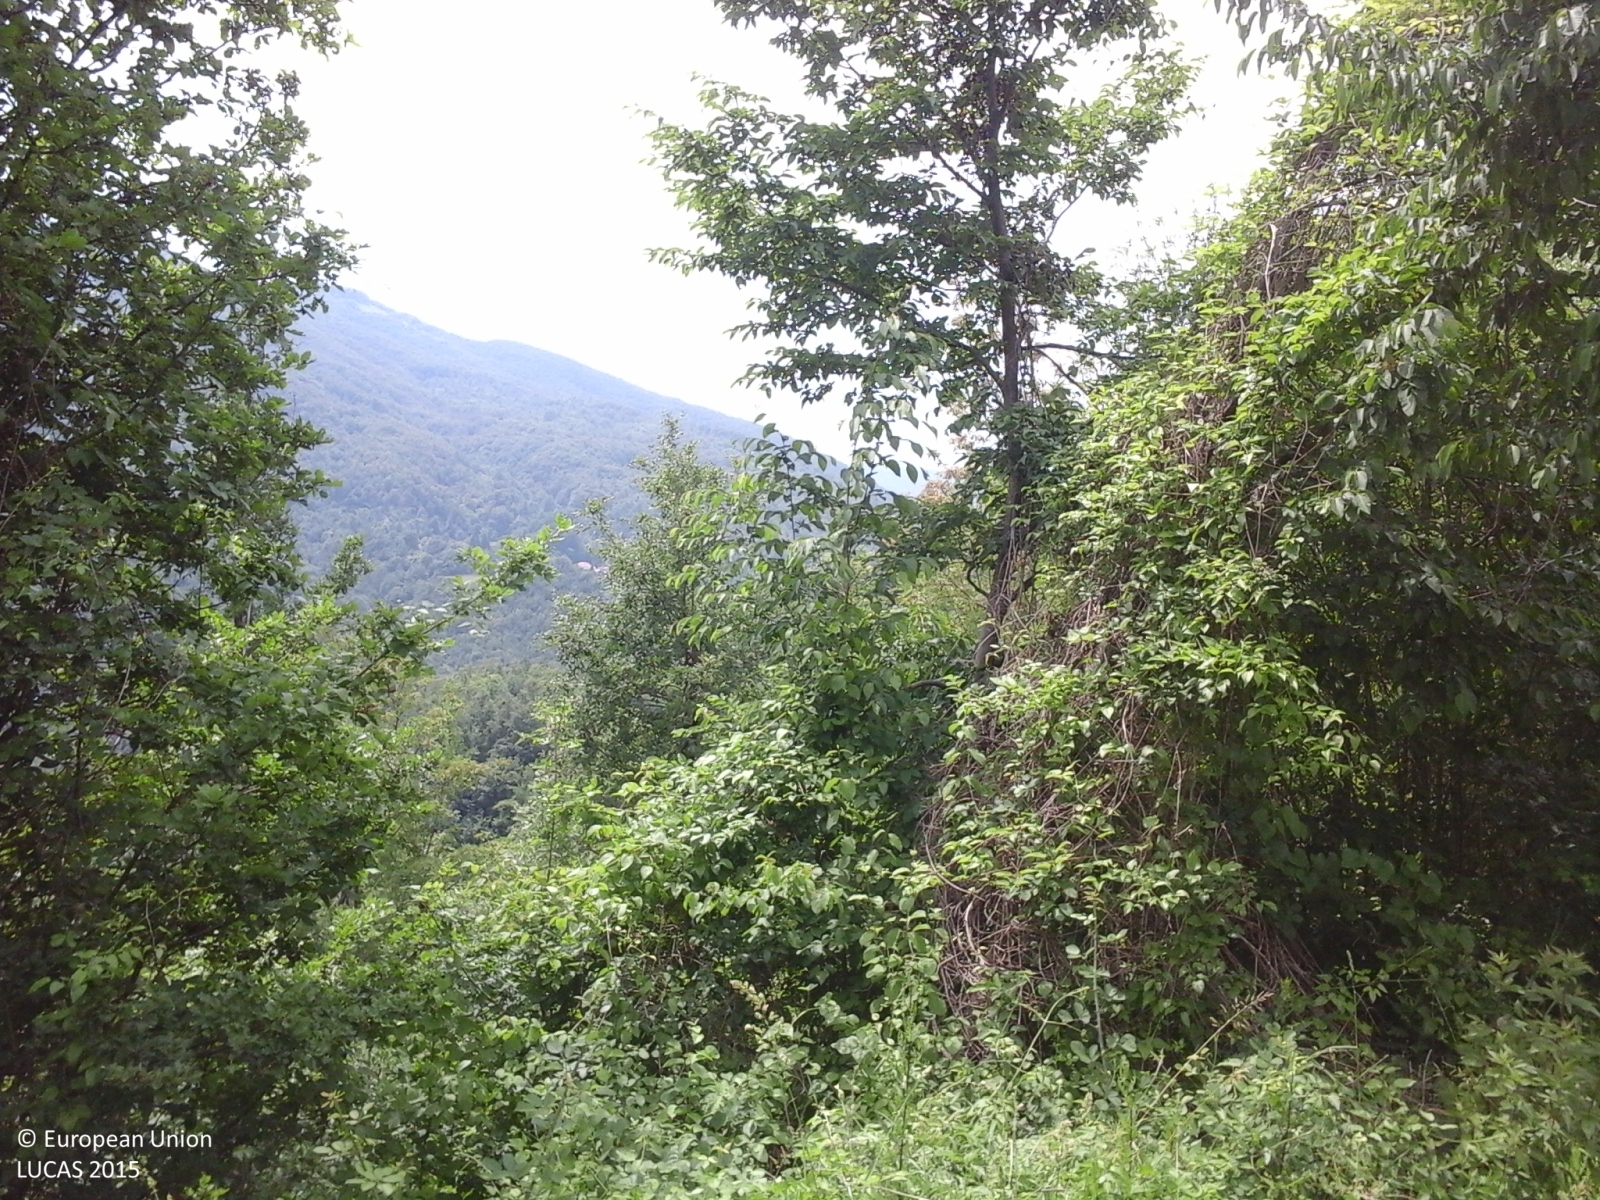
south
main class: Woodland
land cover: Broadleaved woodland
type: thermophilous deciduous forest
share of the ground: > 75 %
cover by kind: broadleaved forest trees 80 %, shrubs 20 %
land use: Forestry
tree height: > 5 m
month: June
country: IT
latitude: 44.6023
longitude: 9.6103
